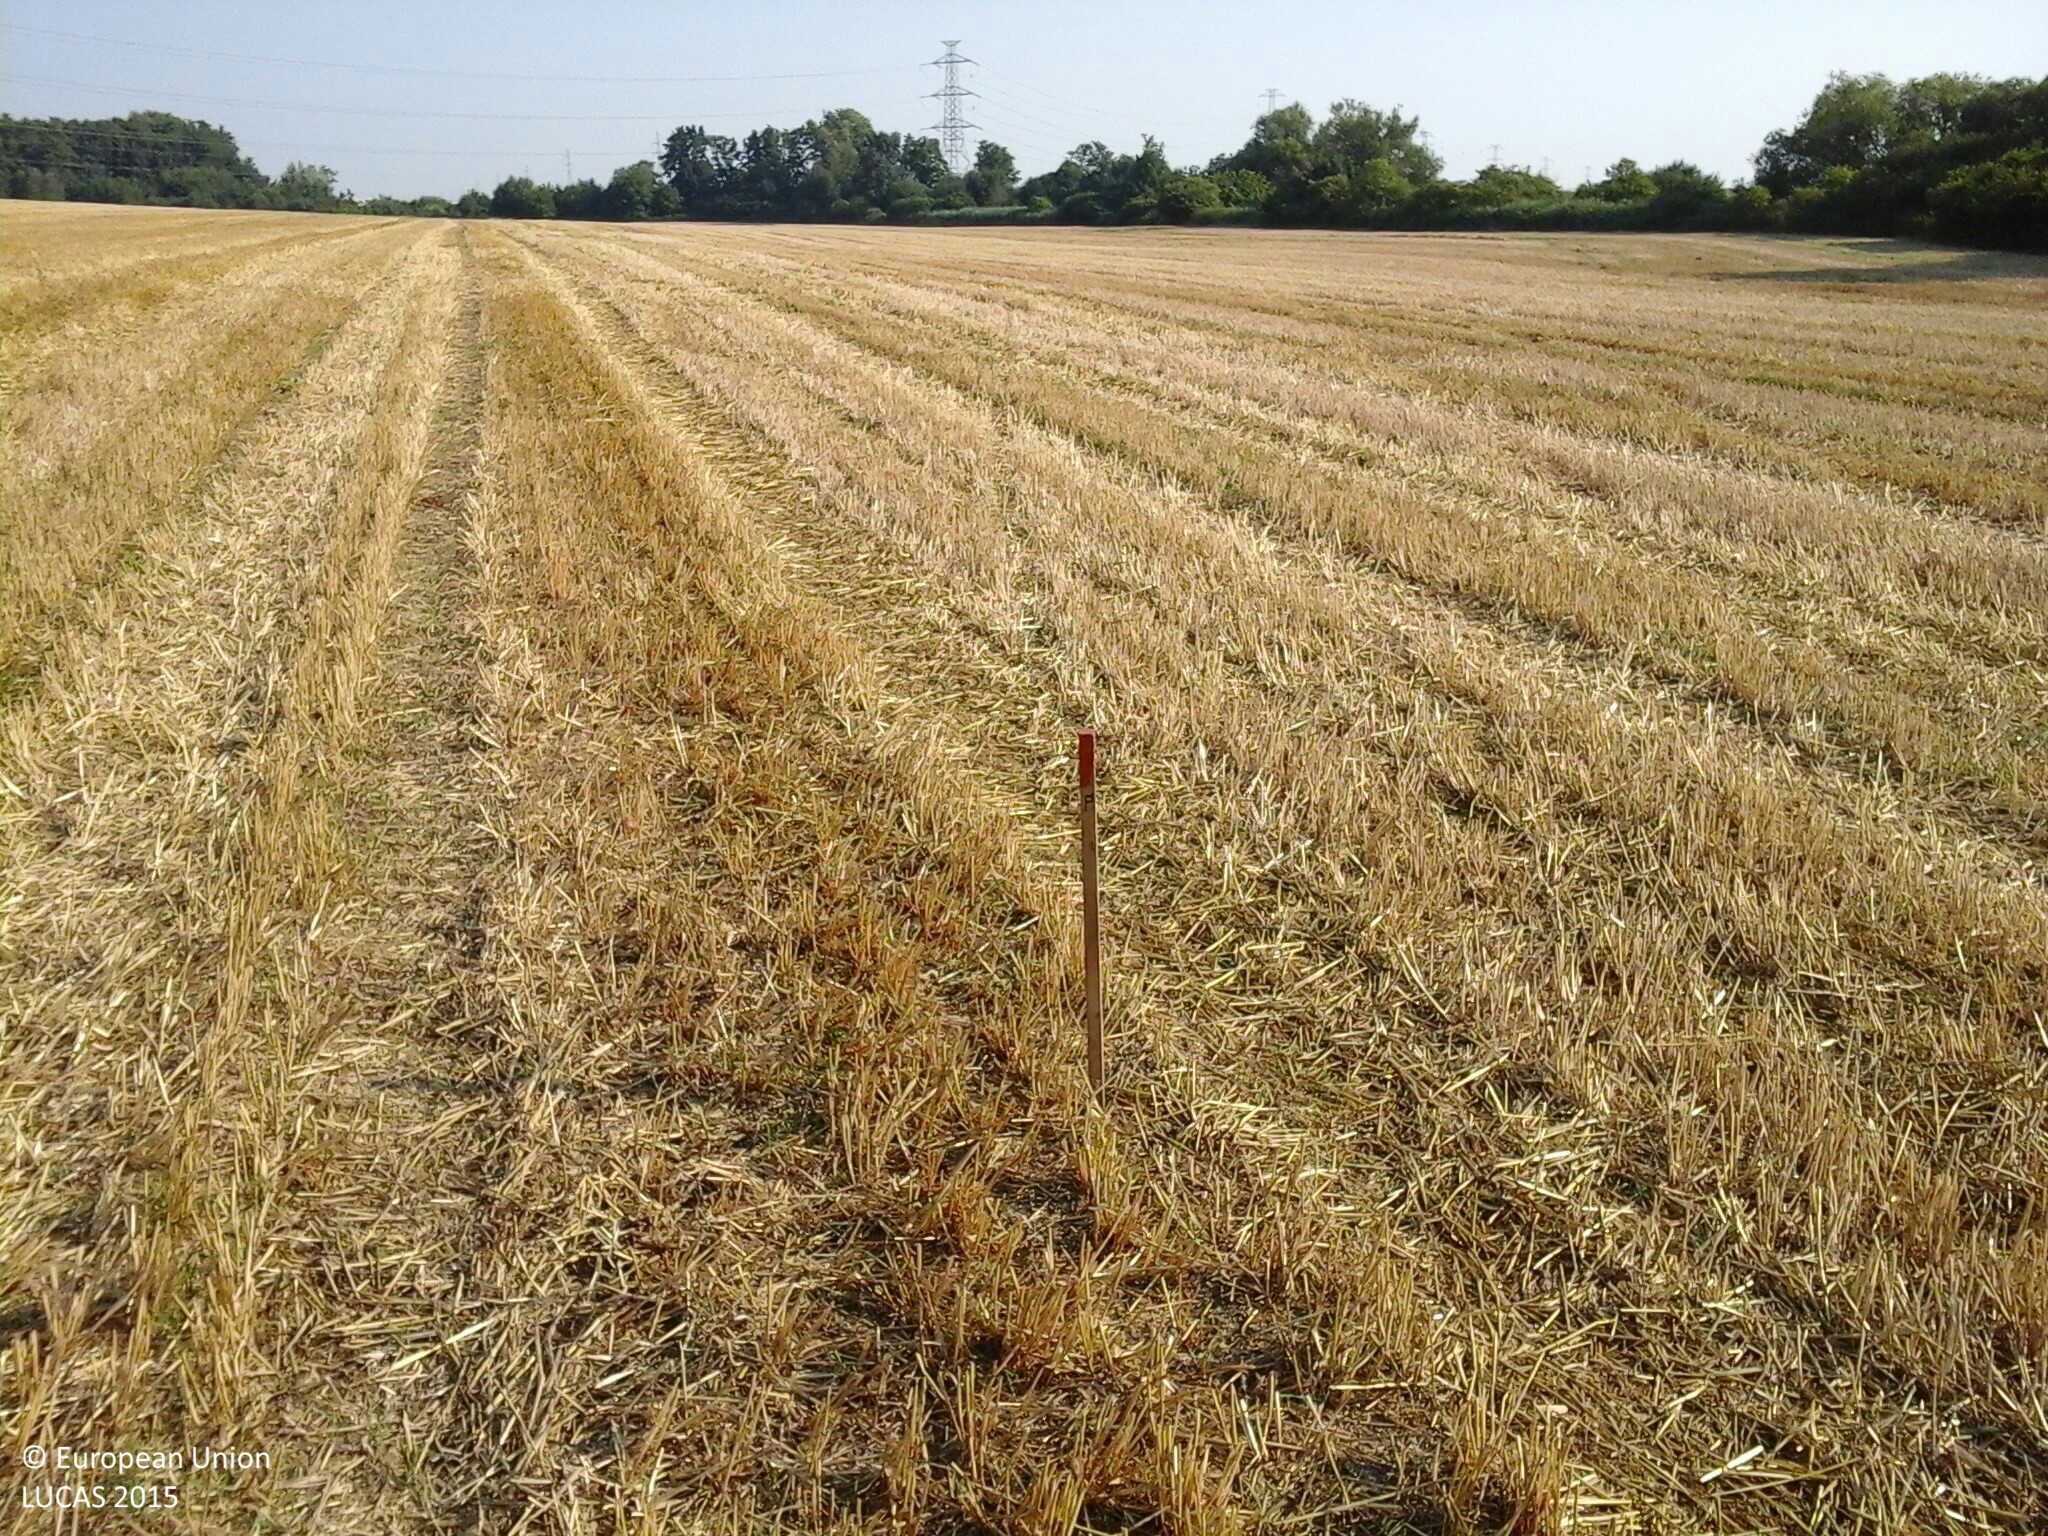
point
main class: Cropland
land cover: Common wheat
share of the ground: 25 - 50 %
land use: Agriculture (excluding fallow land and kitchen gardens)
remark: Harvested field
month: August
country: HU
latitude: 47.2430
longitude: 16.7019
